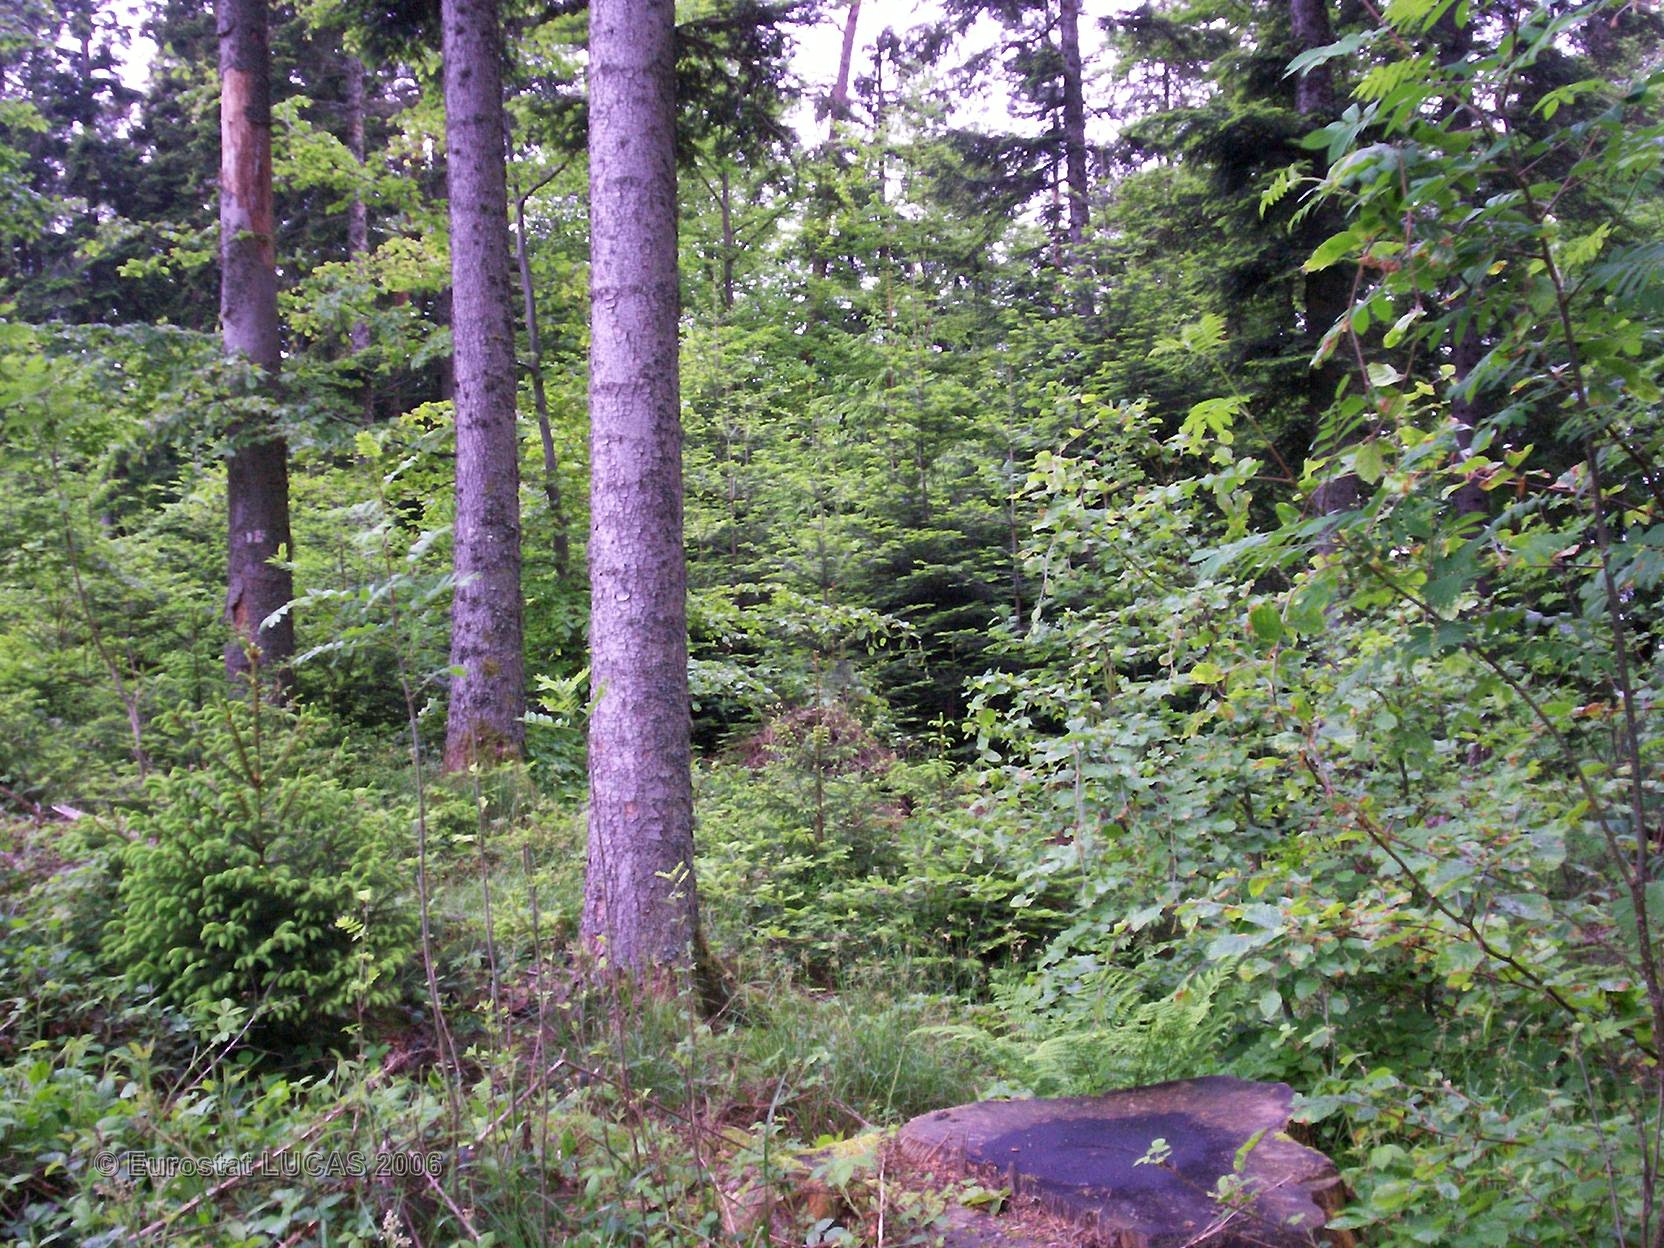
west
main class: Woodland
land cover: Mixed forest
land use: Forestry
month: May
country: FR
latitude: 48.1588
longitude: 6.7879
